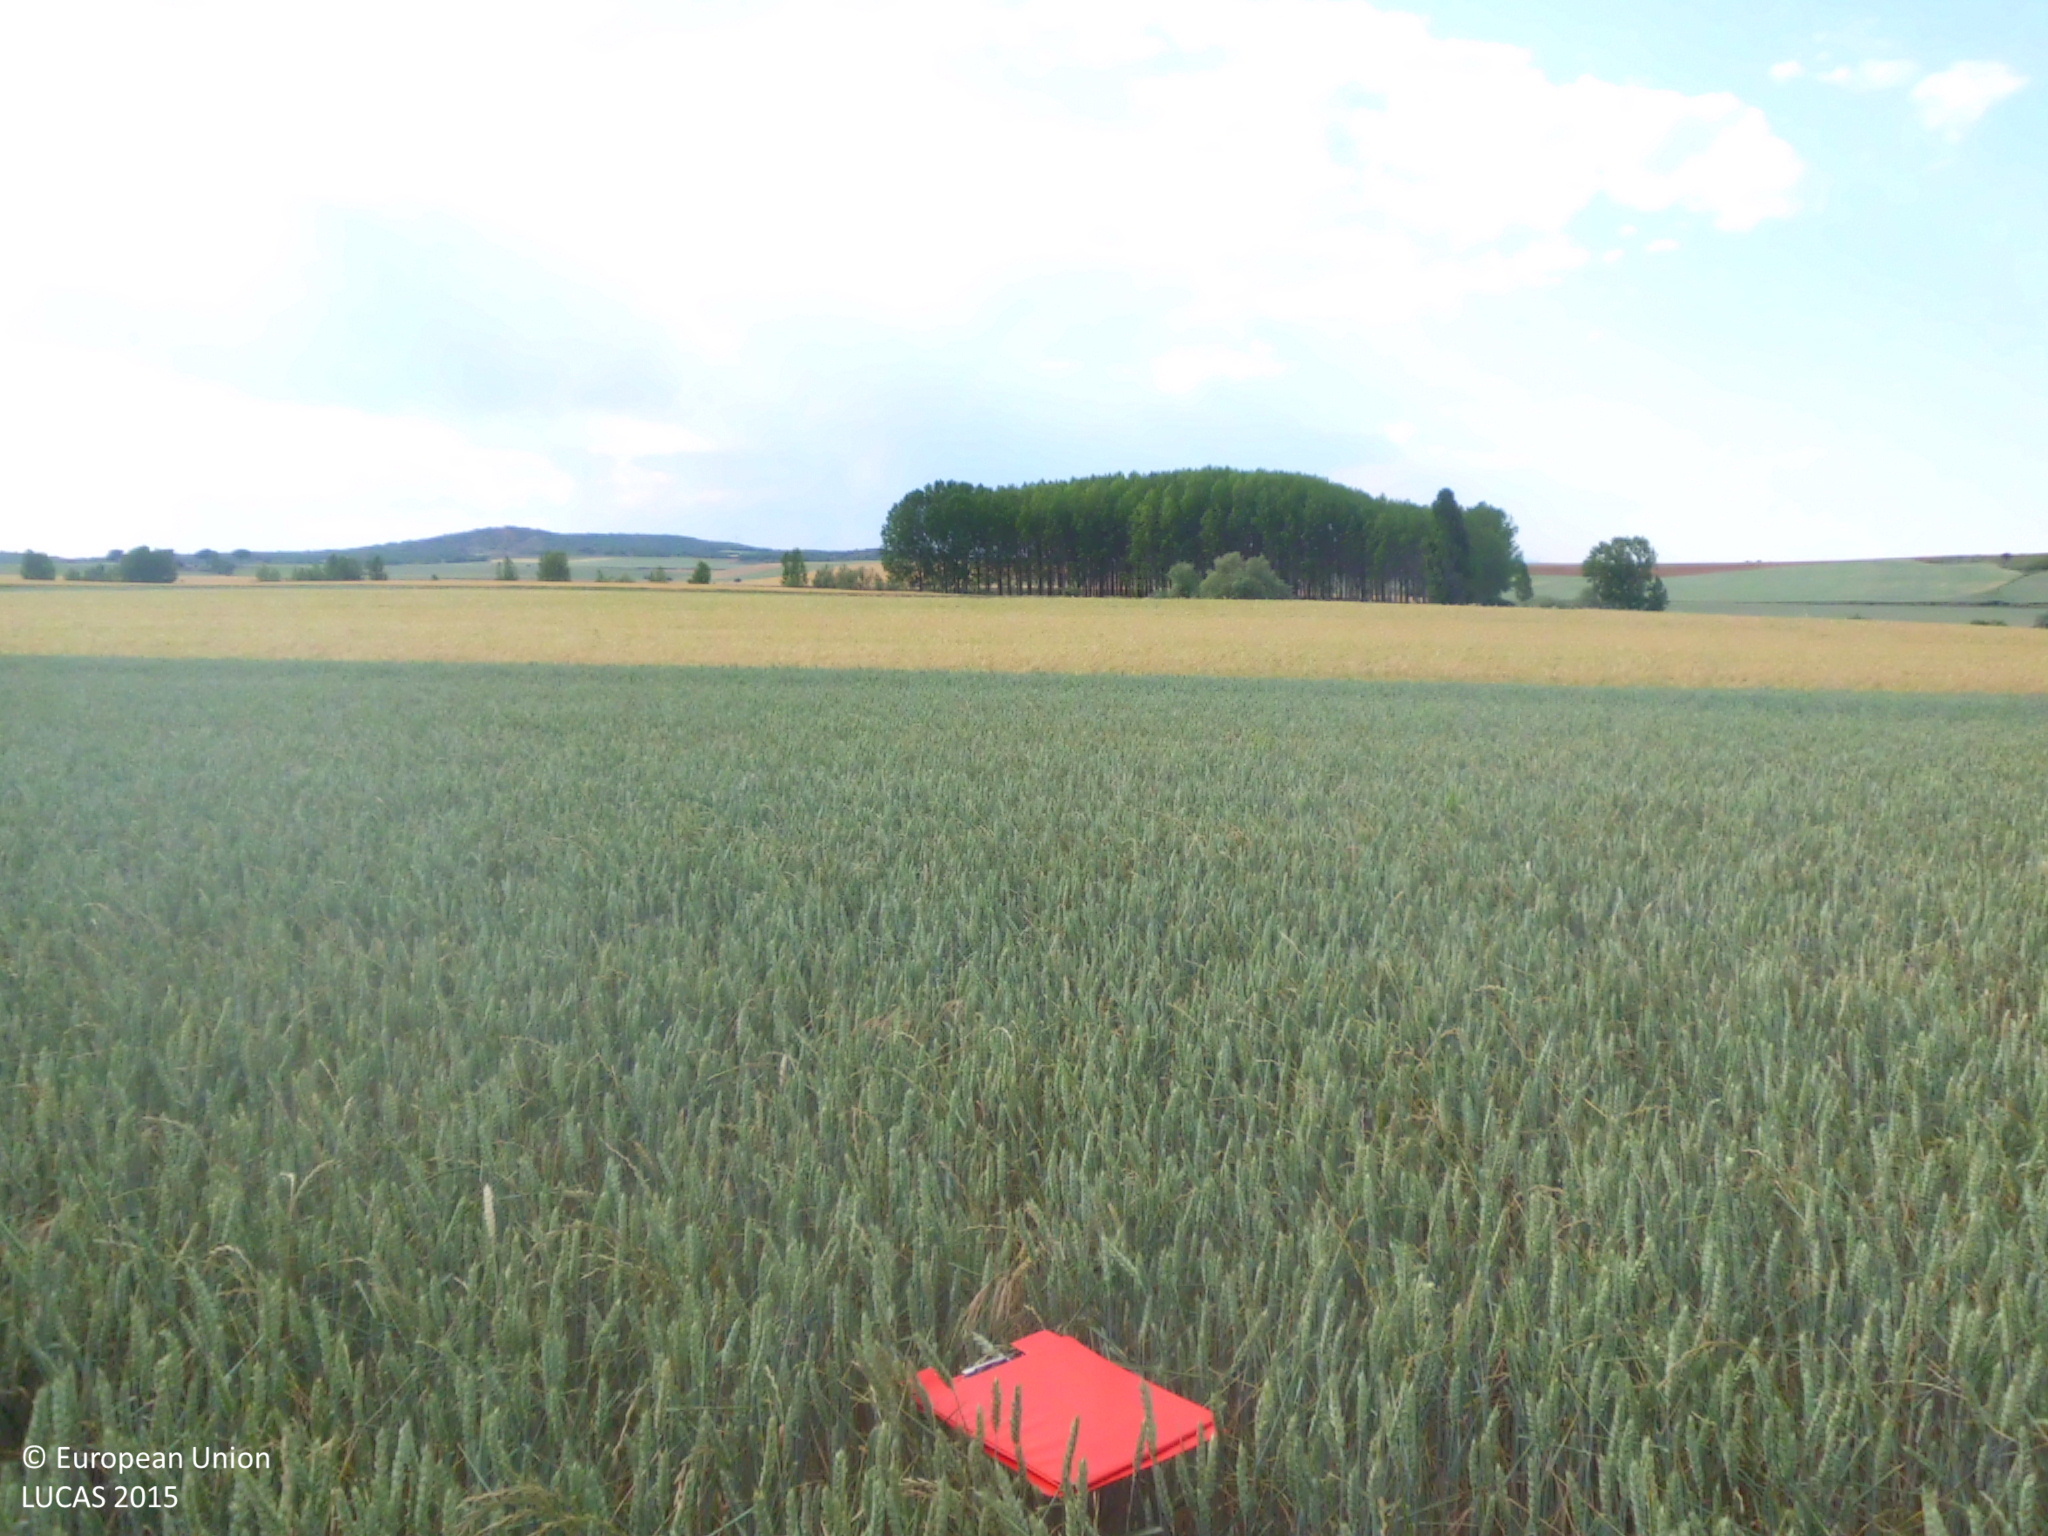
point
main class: Cropland
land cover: Common wheat
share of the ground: > 75 %
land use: Agriculture (excluding fallow land and kitchen gardens)
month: June
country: ES
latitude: 42.5163
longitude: -4.3999
